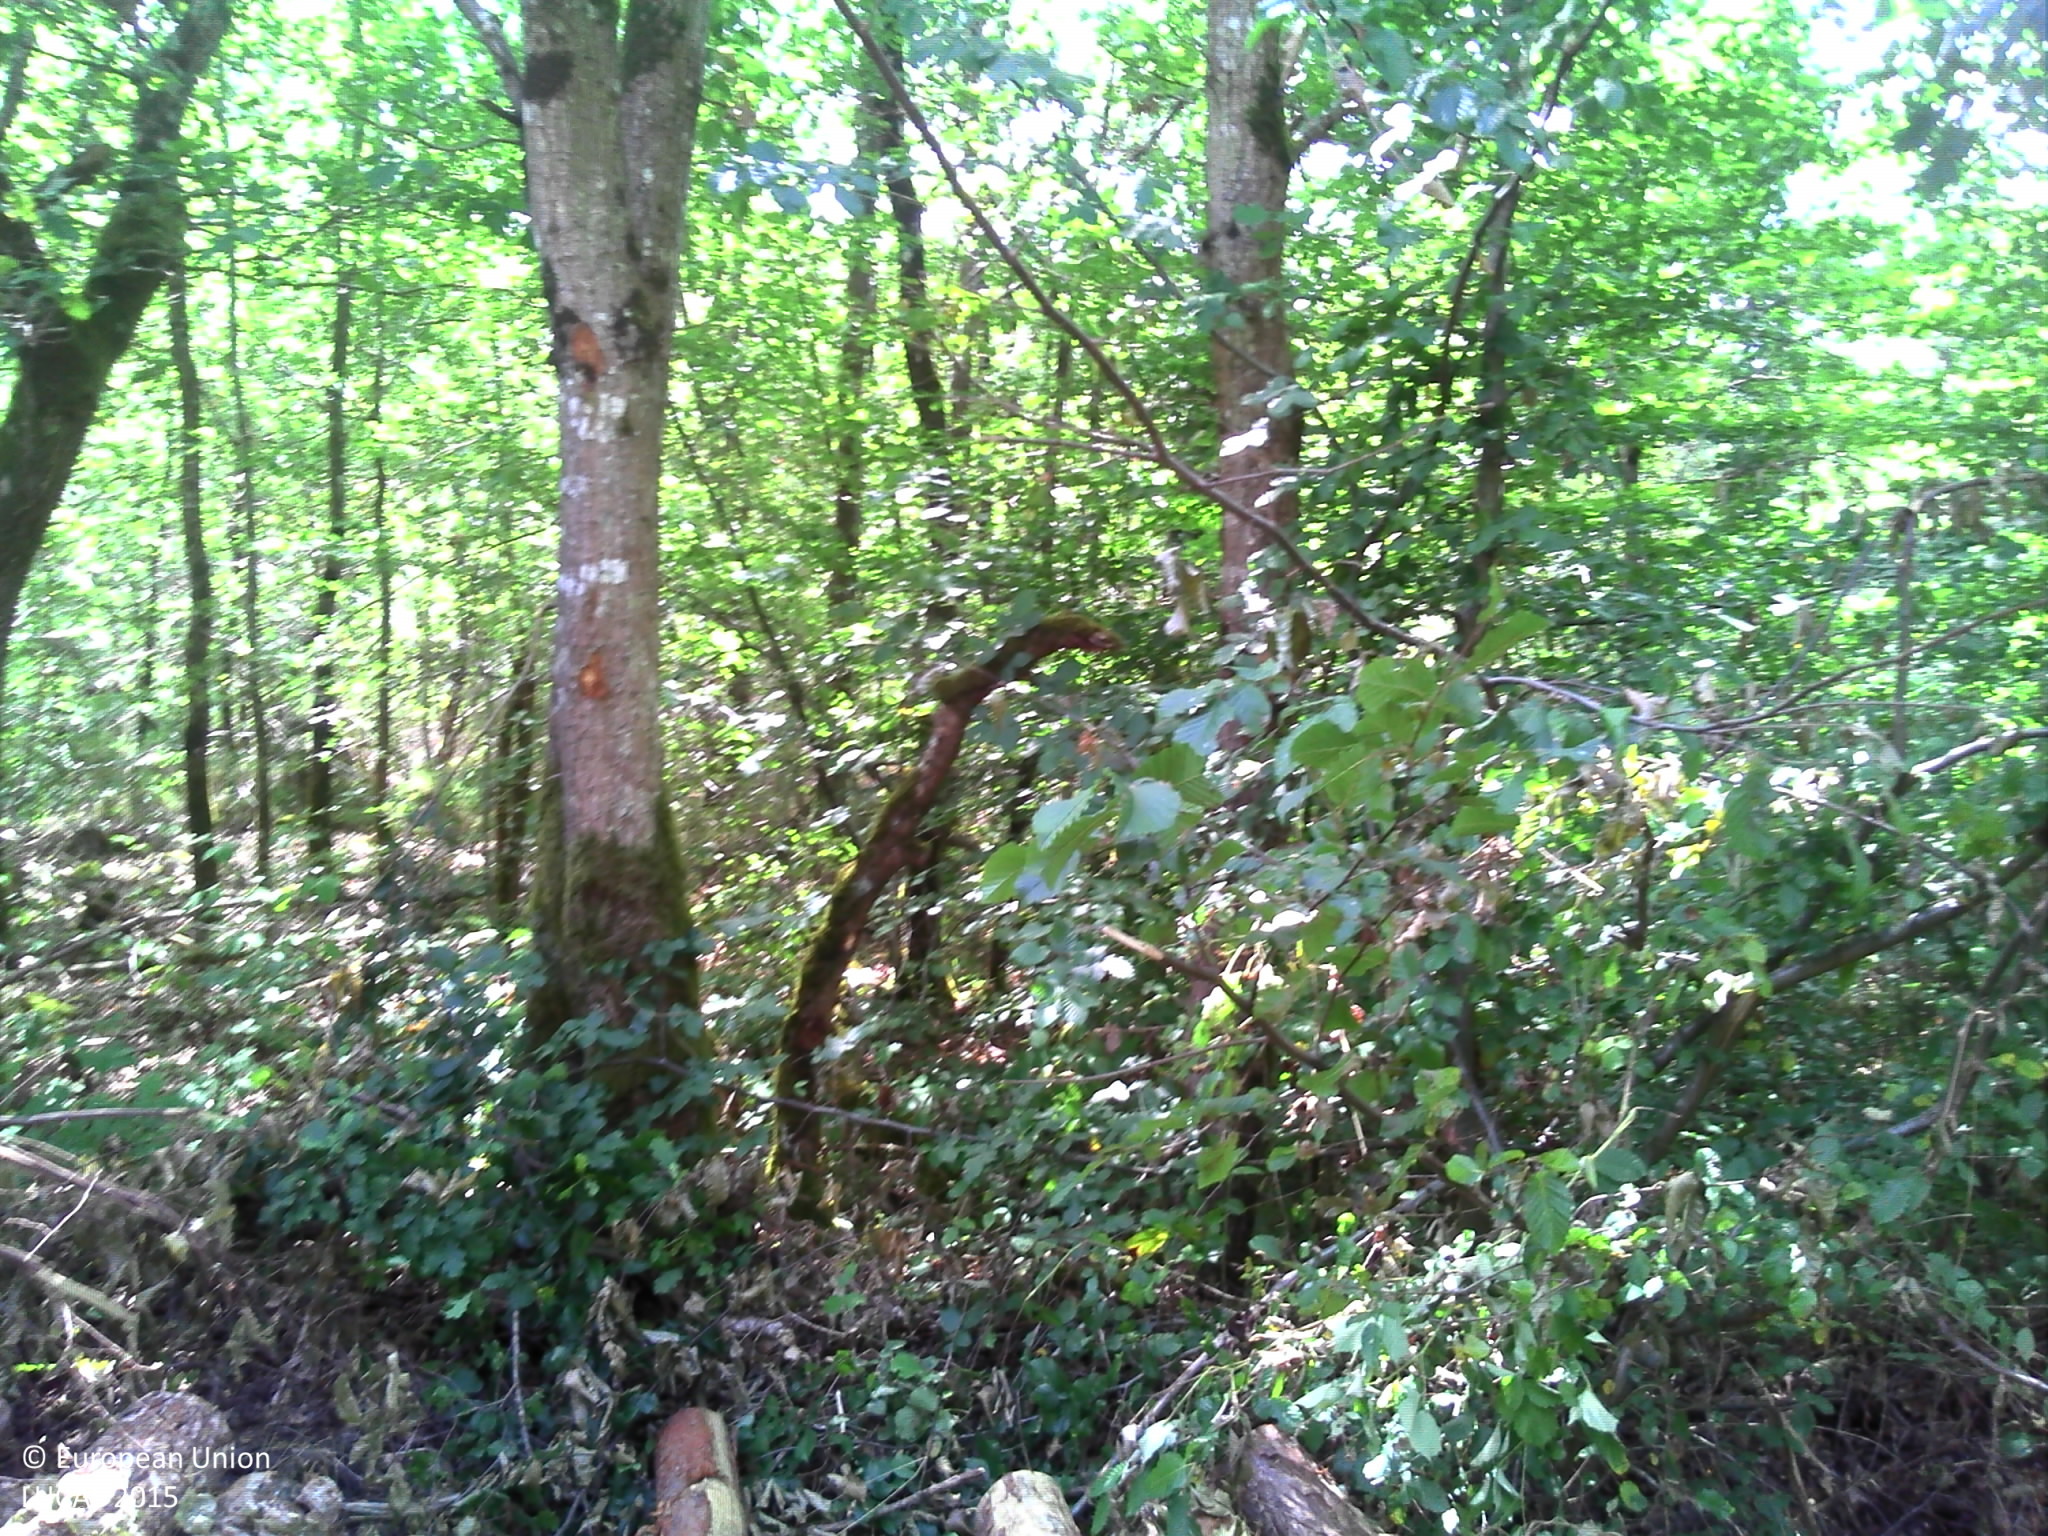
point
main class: Woodland
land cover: Broadleaved woodland
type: mesophytic deciduous forest
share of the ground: > 75 %
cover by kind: broadleaved forest trees 100 %
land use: Forestry
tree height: > 5 m
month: July
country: FR
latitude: 47.9840
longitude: 1.9619
